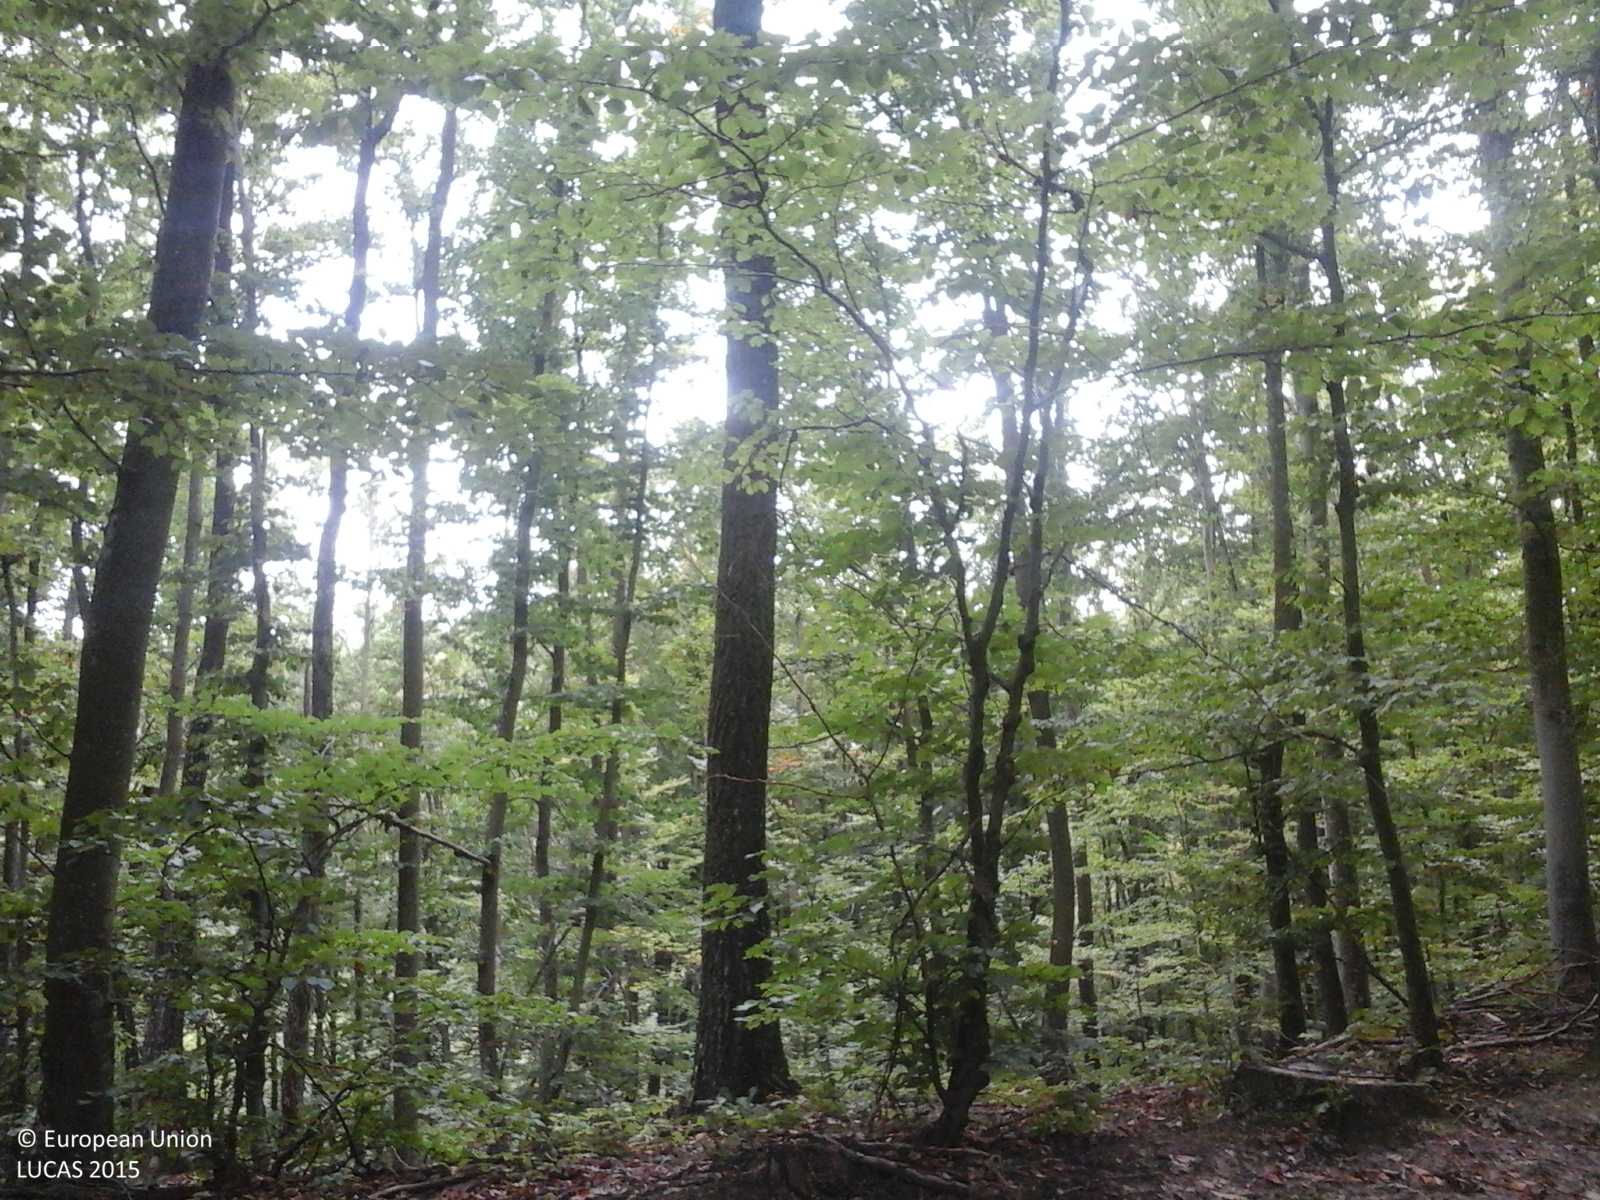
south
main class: Woodland
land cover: Broadleaved woodland
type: beech forest
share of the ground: > 75 %
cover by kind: broadleaved forest trees 100 %
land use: Forestry
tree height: > 5 m
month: September
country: RO
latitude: 45.7748
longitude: 22.2219
